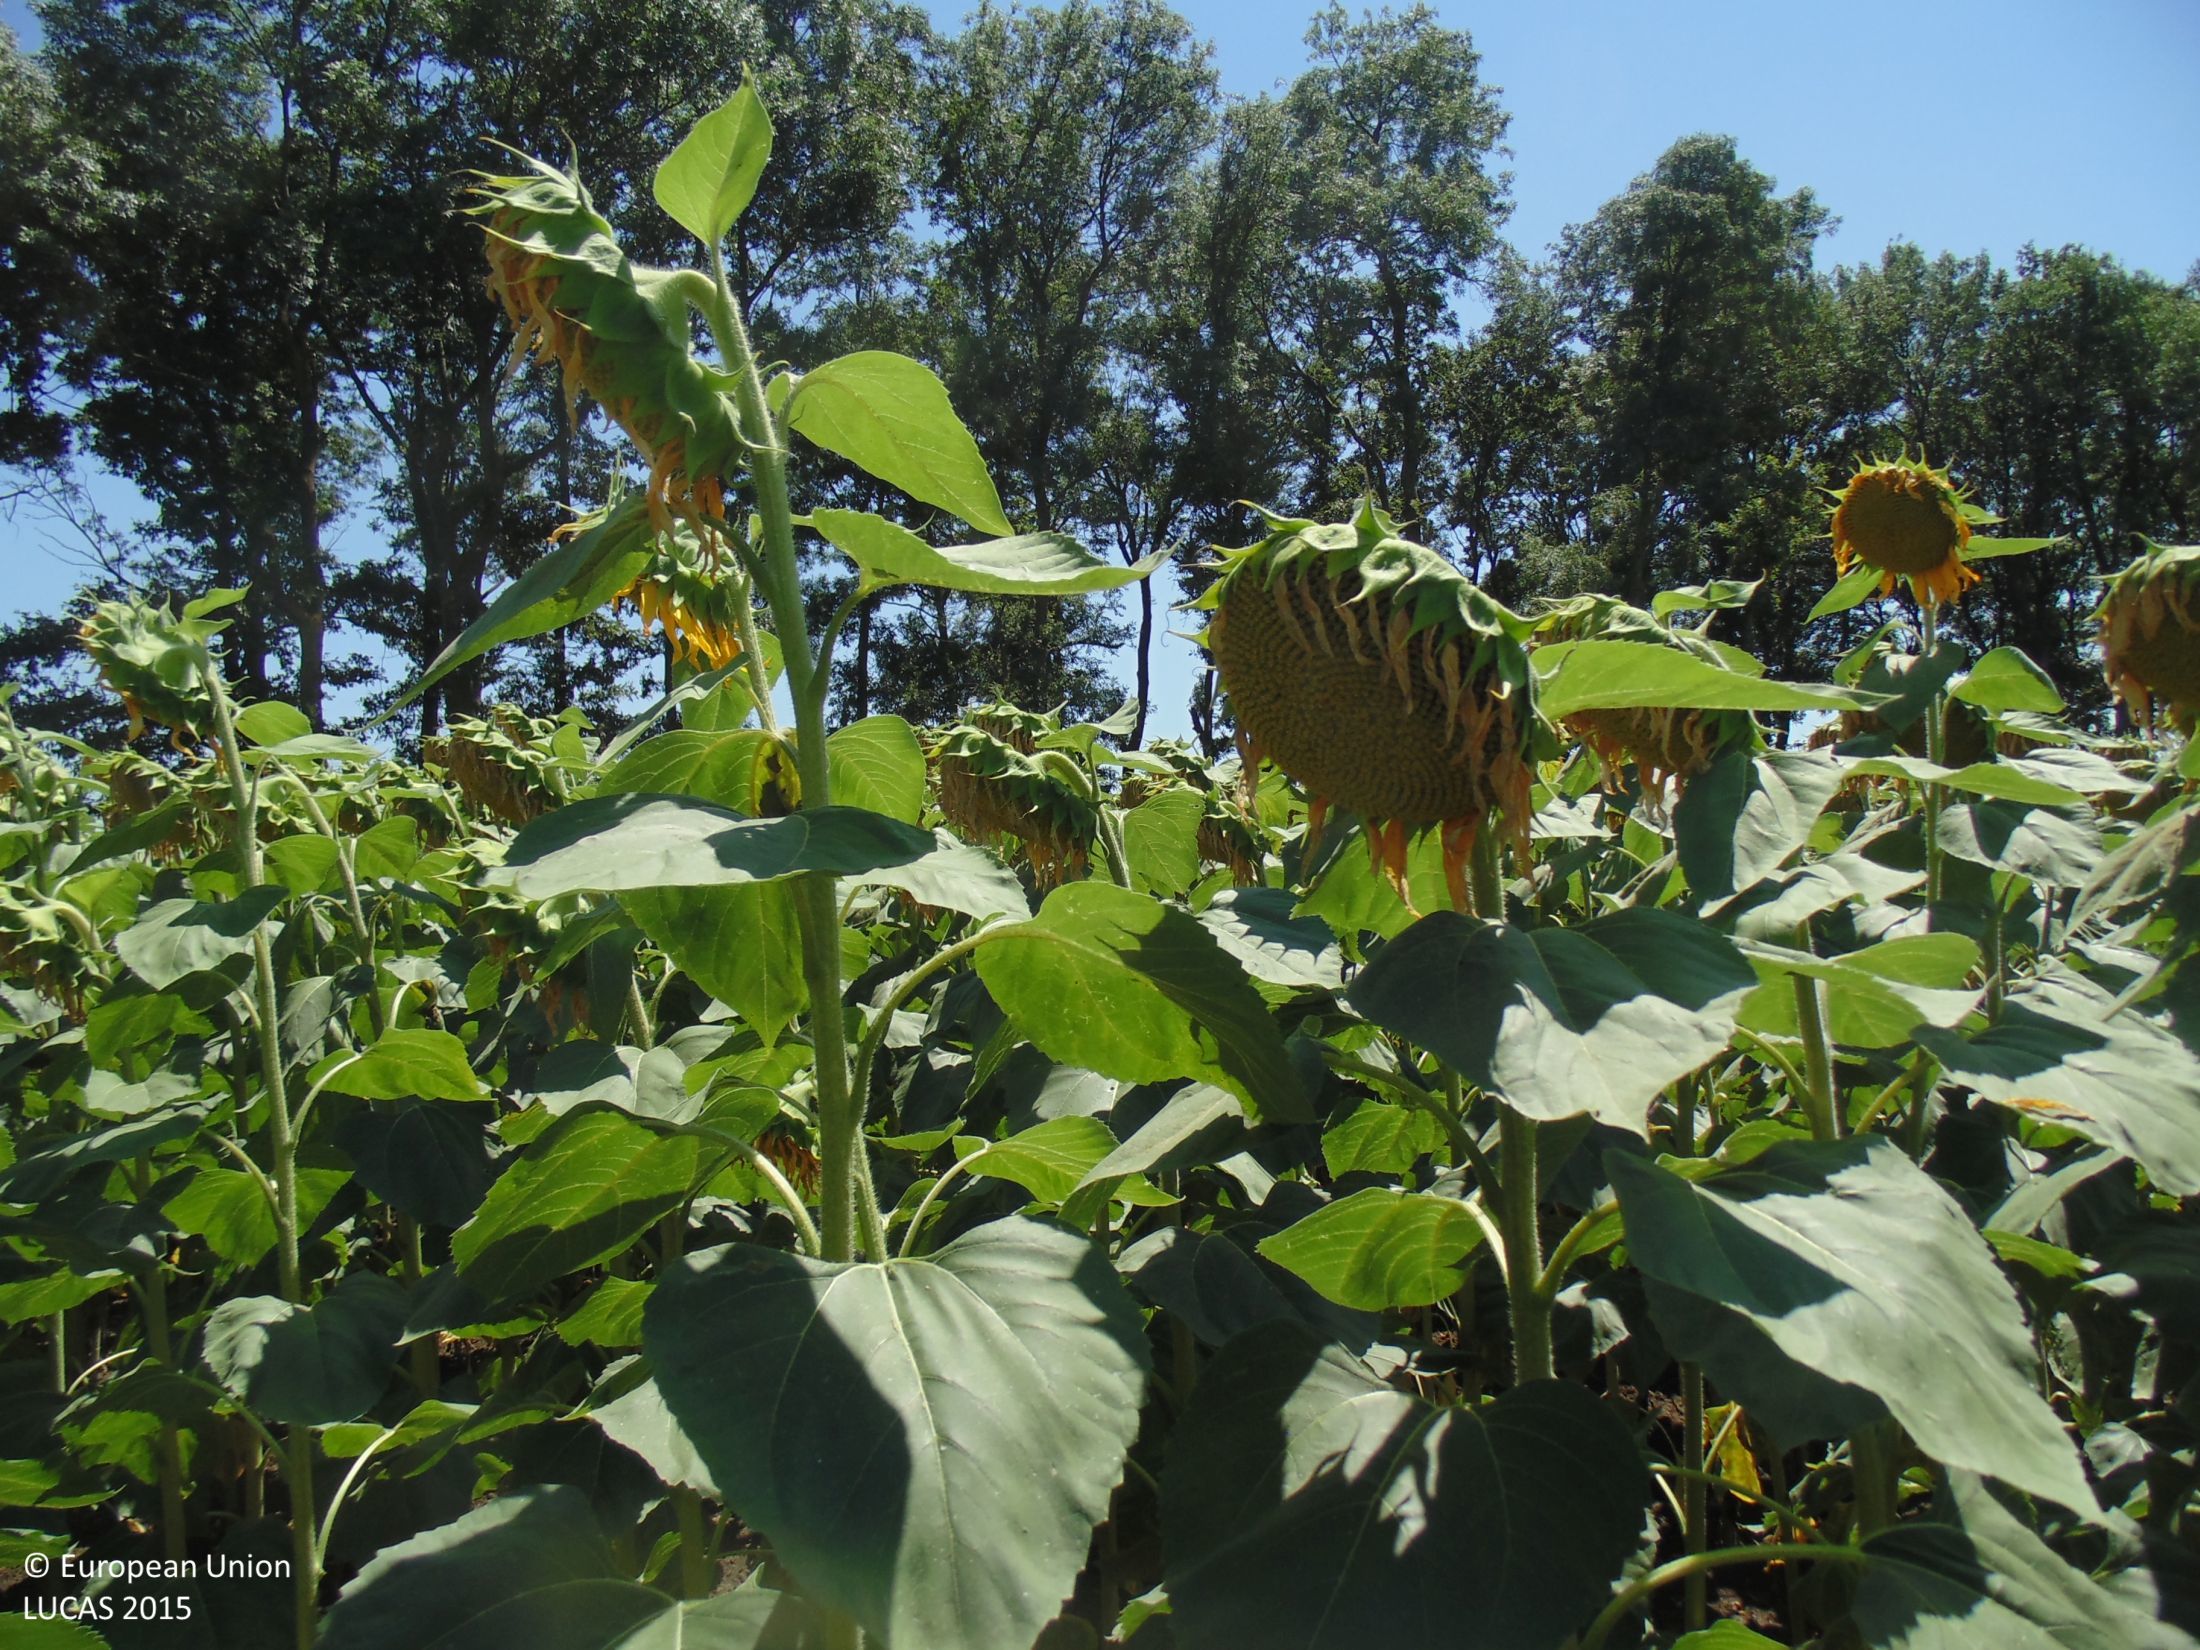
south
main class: Cropland
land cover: Sunflower
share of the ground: > 75 %
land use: Agriculture (excluding fallow land and kitchen gardens)
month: July
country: BG
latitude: 43.4914
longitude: 28.1419
